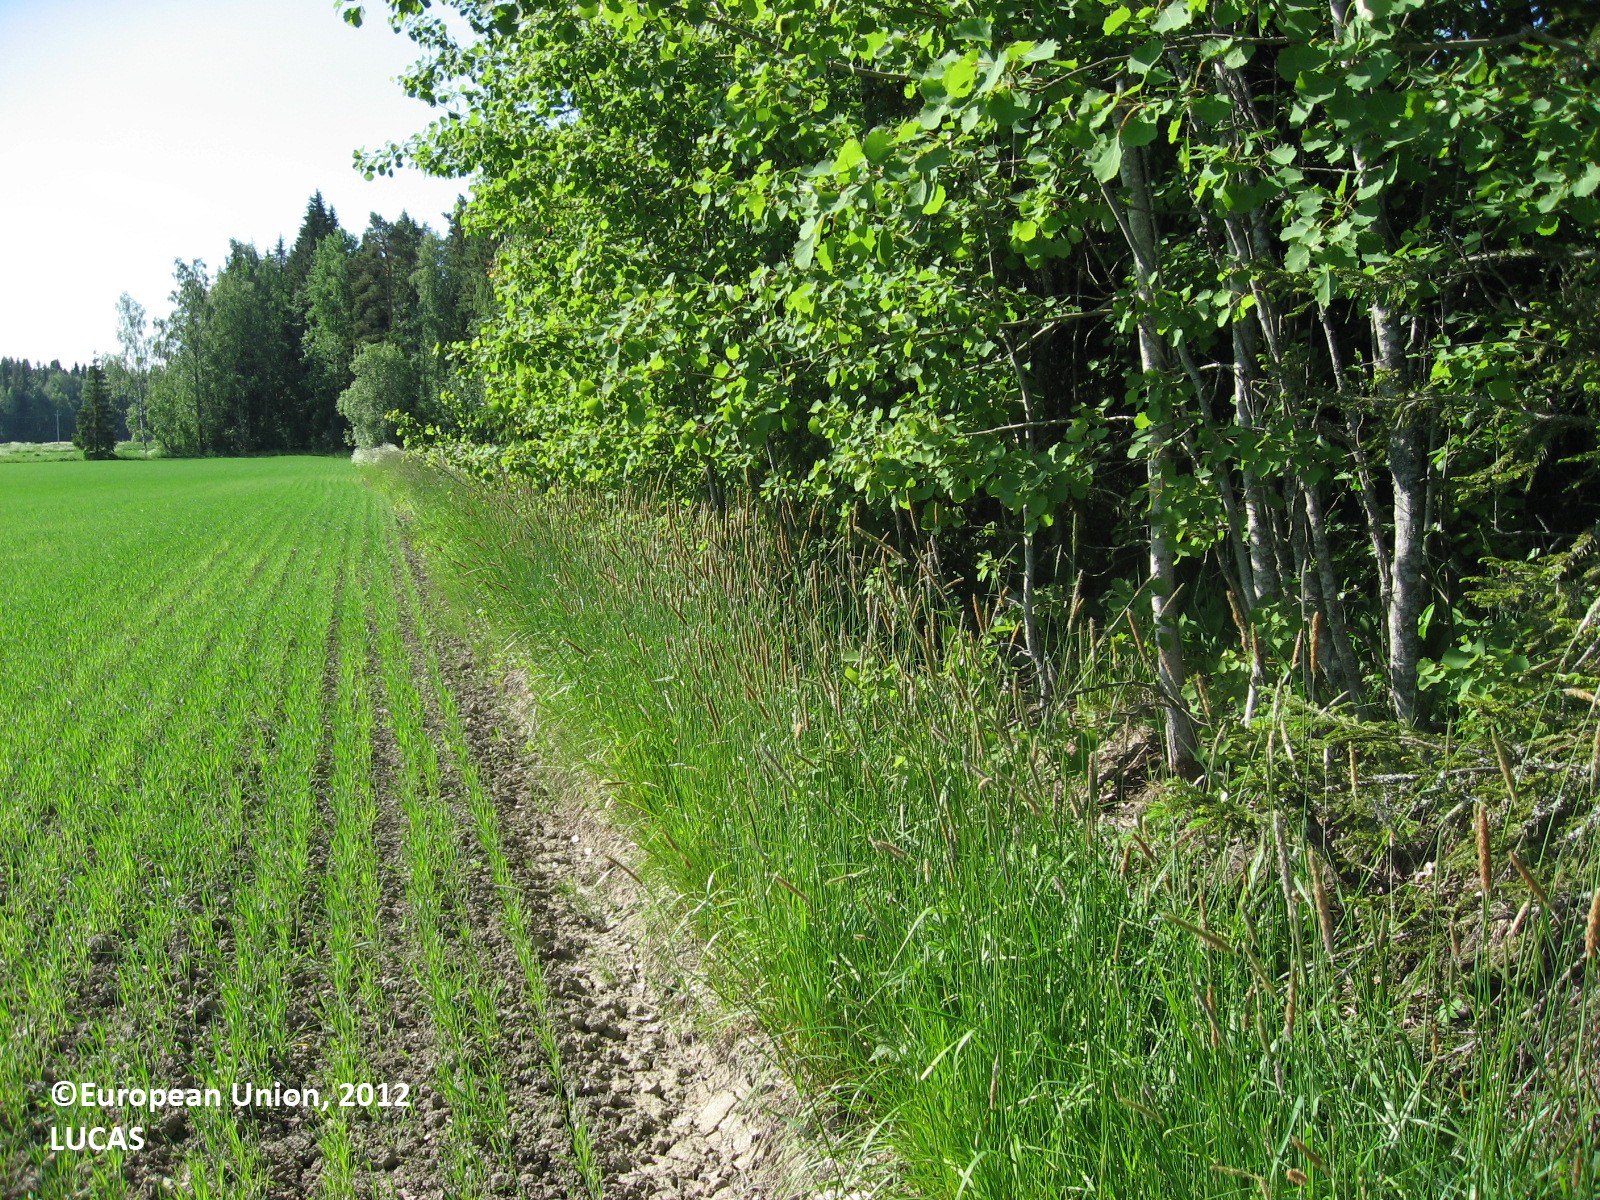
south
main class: Cropland
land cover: Common wheat
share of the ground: 50 - 75 %
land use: Agriculture (excluding fallow land and kitchen gardens)
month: June
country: FI
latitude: 60.4728
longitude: 25.0158
